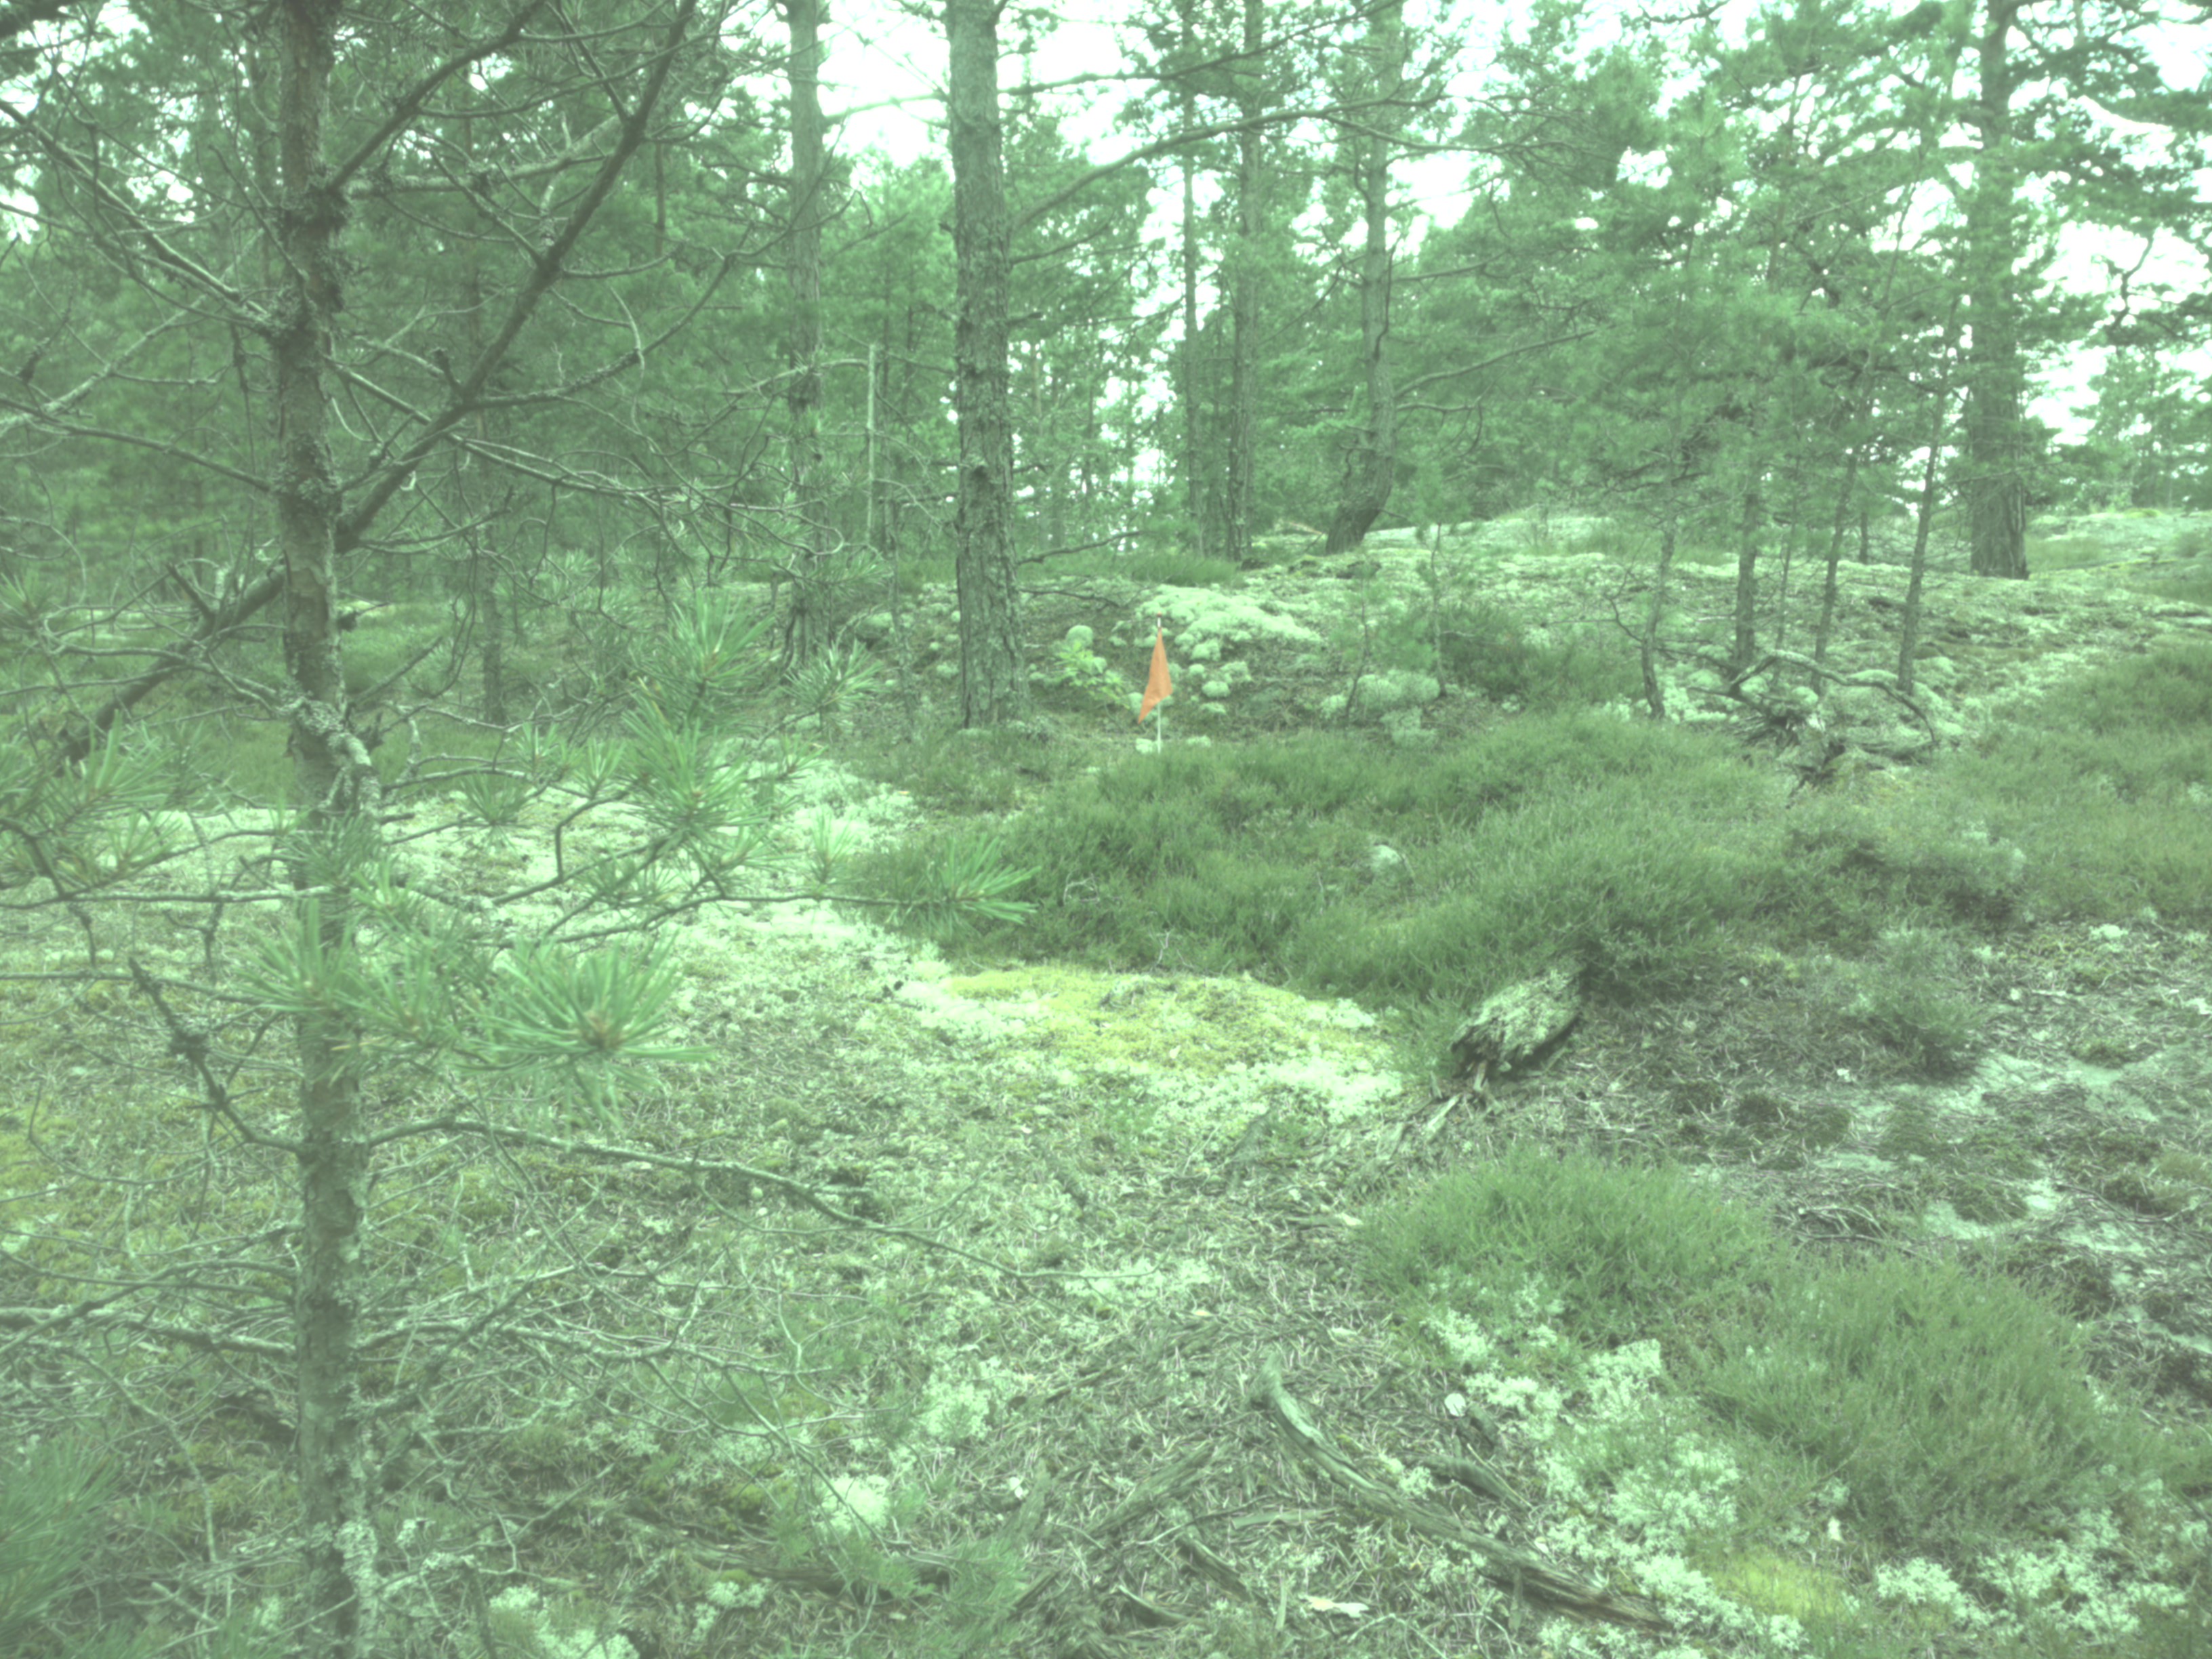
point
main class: Woodland
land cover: Pine dominated coniferous woodland
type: boreal forest
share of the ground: 25 - 50 %
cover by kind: shrubs 35 %, lichens and mosses 35 %, coniferous forest trees 30 %
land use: Forestry
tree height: > 5 m
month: July
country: SE
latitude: 59.0917
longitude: 18.1862
